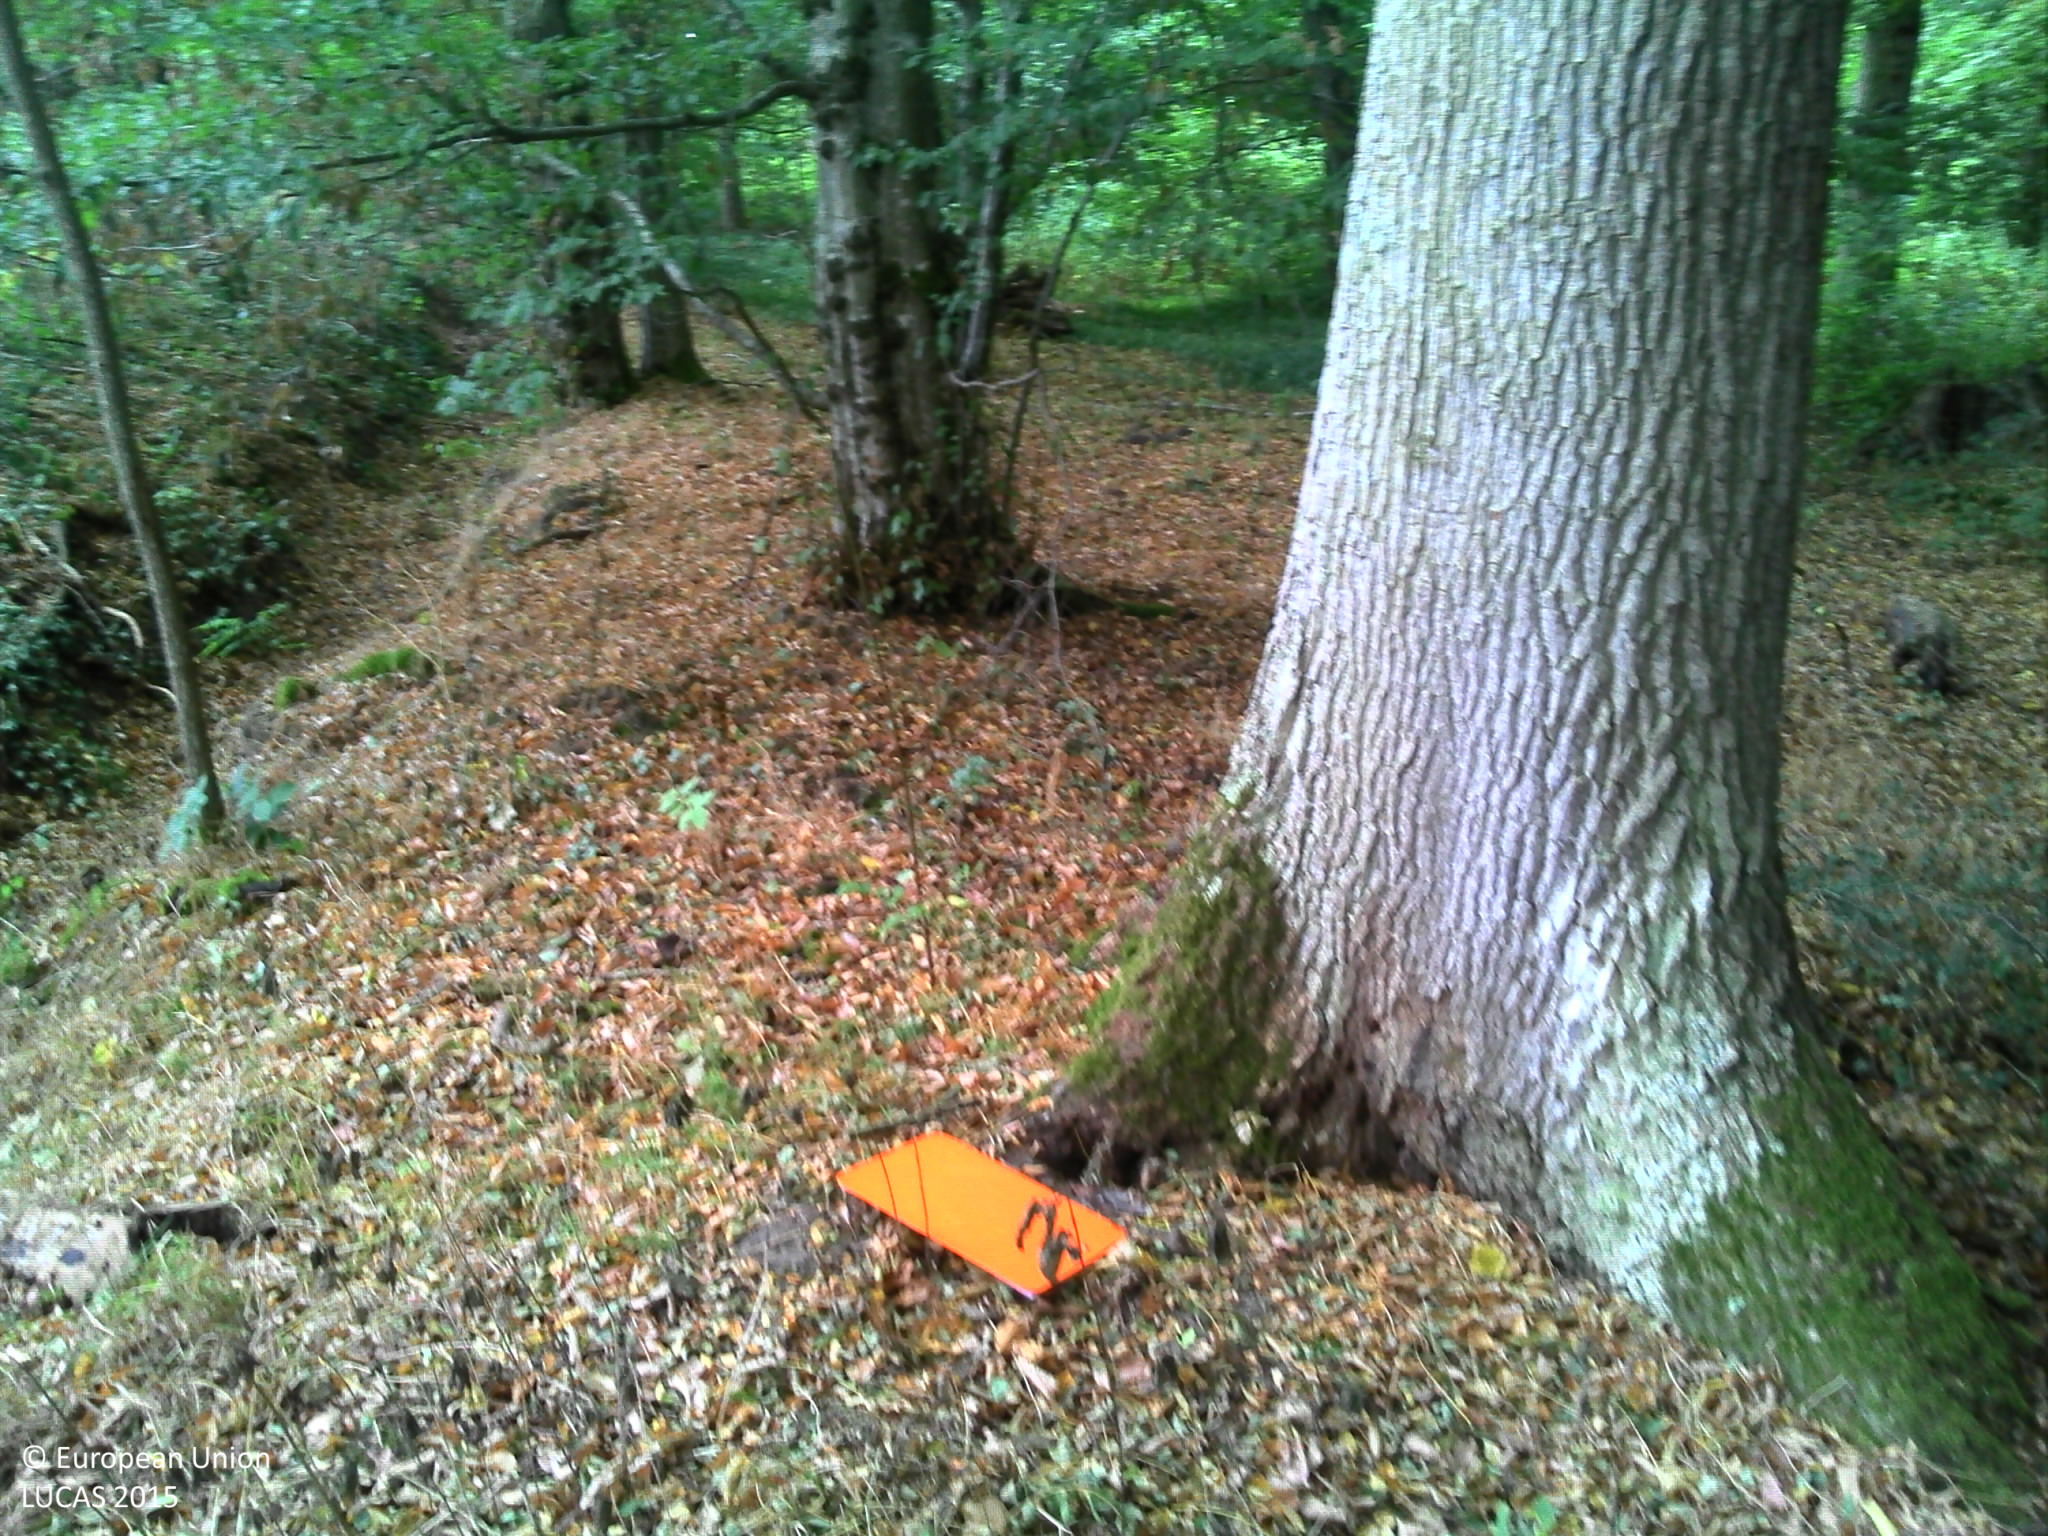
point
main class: Woodland
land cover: Broadleaved woodland
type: mesophytic deciduous forest
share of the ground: > 75 %
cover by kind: broadleaved forest trees 100 %
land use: Forestry
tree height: > 5 m
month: July
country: FR
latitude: 47.8768
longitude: 2.4897
